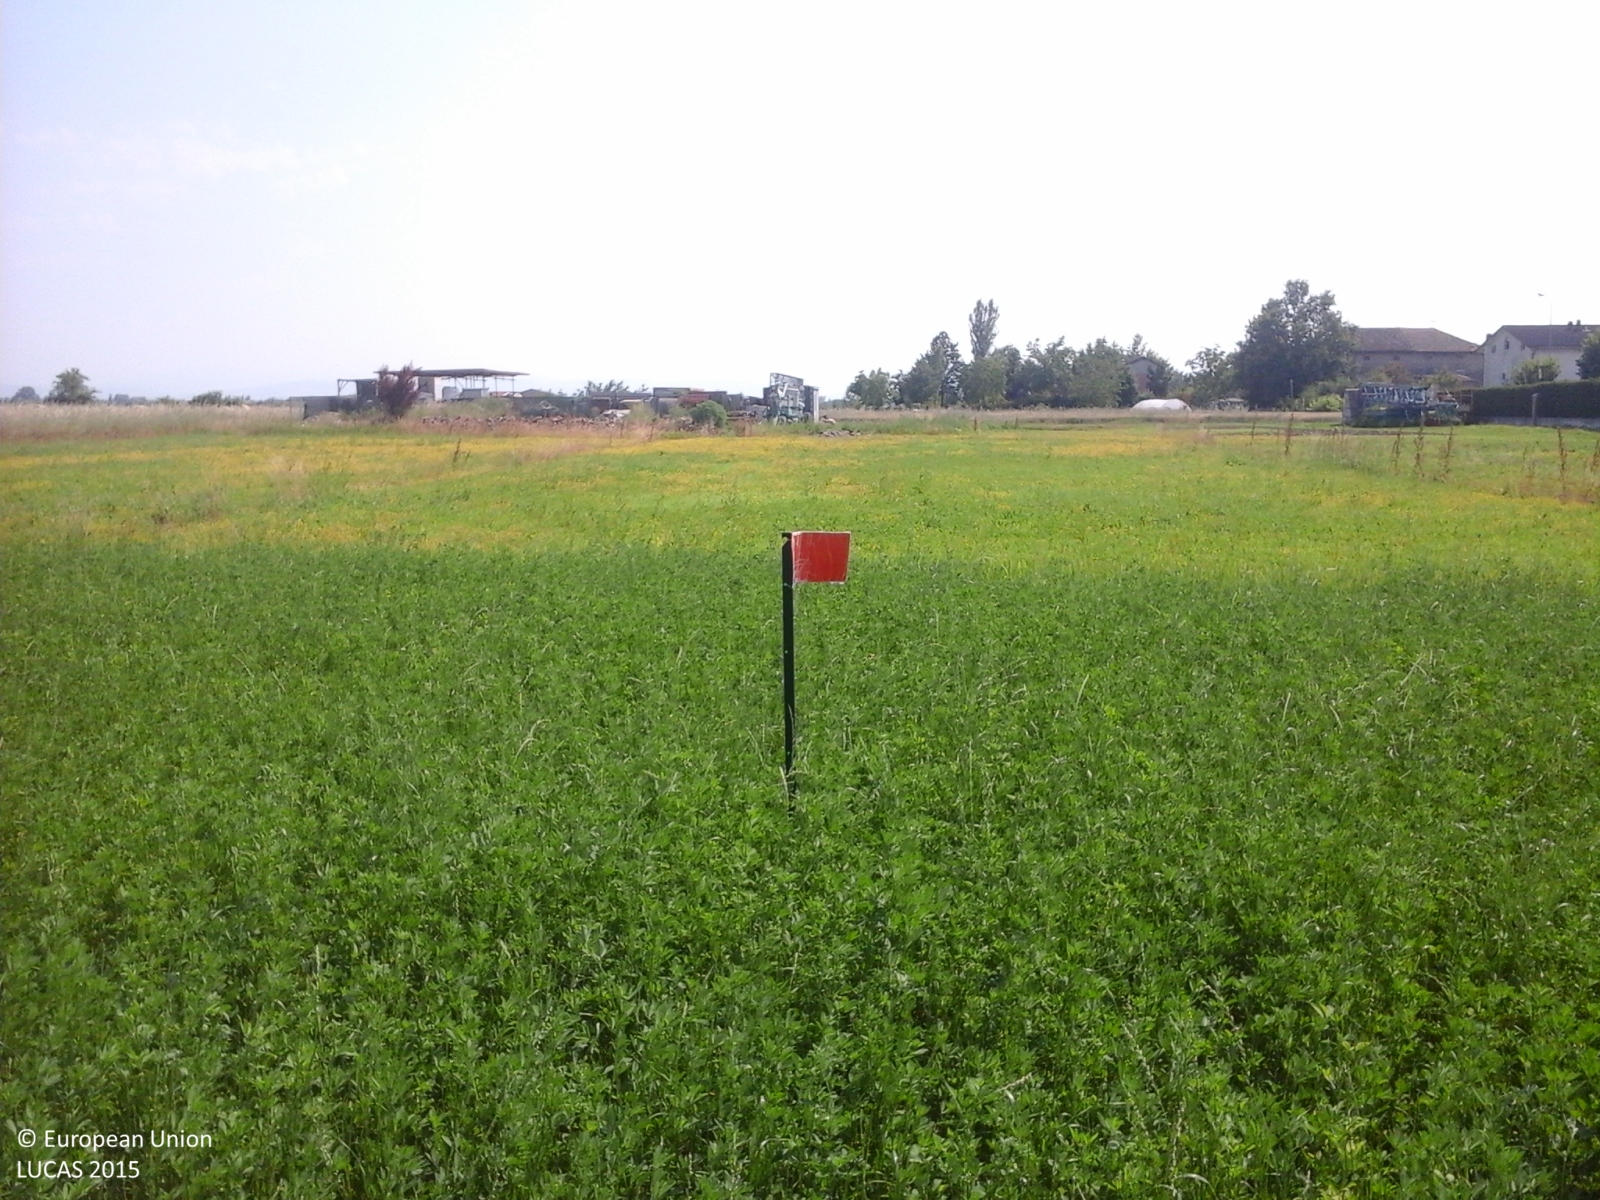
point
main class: Cropland
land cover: Lucerne
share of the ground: > 75 %
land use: Agriculture (excluding fallow land and kitchen gardens)
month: June
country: IT
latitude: 44.7996
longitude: 10.6182
